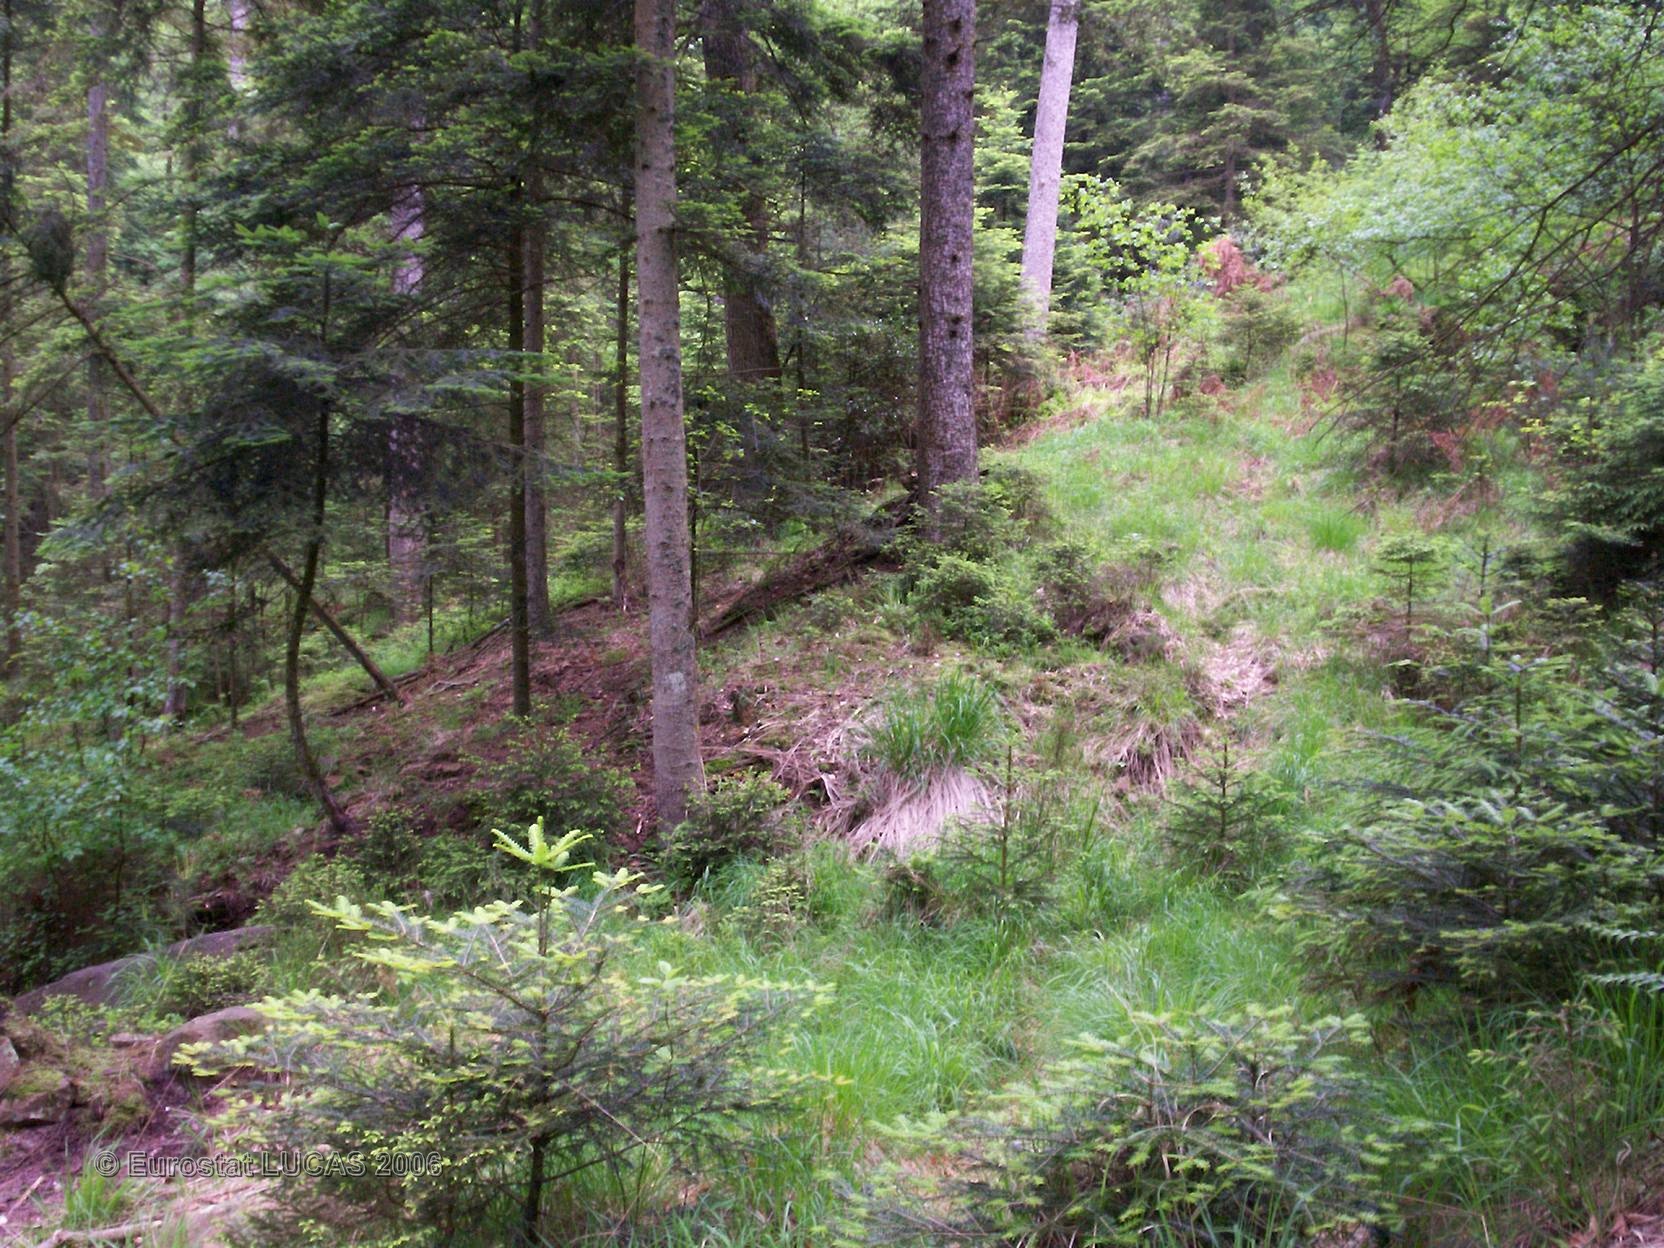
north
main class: Woodland
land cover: Mixed forest
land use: Forestry
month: June
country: FR
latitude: 48.3760
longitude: 6.8281
